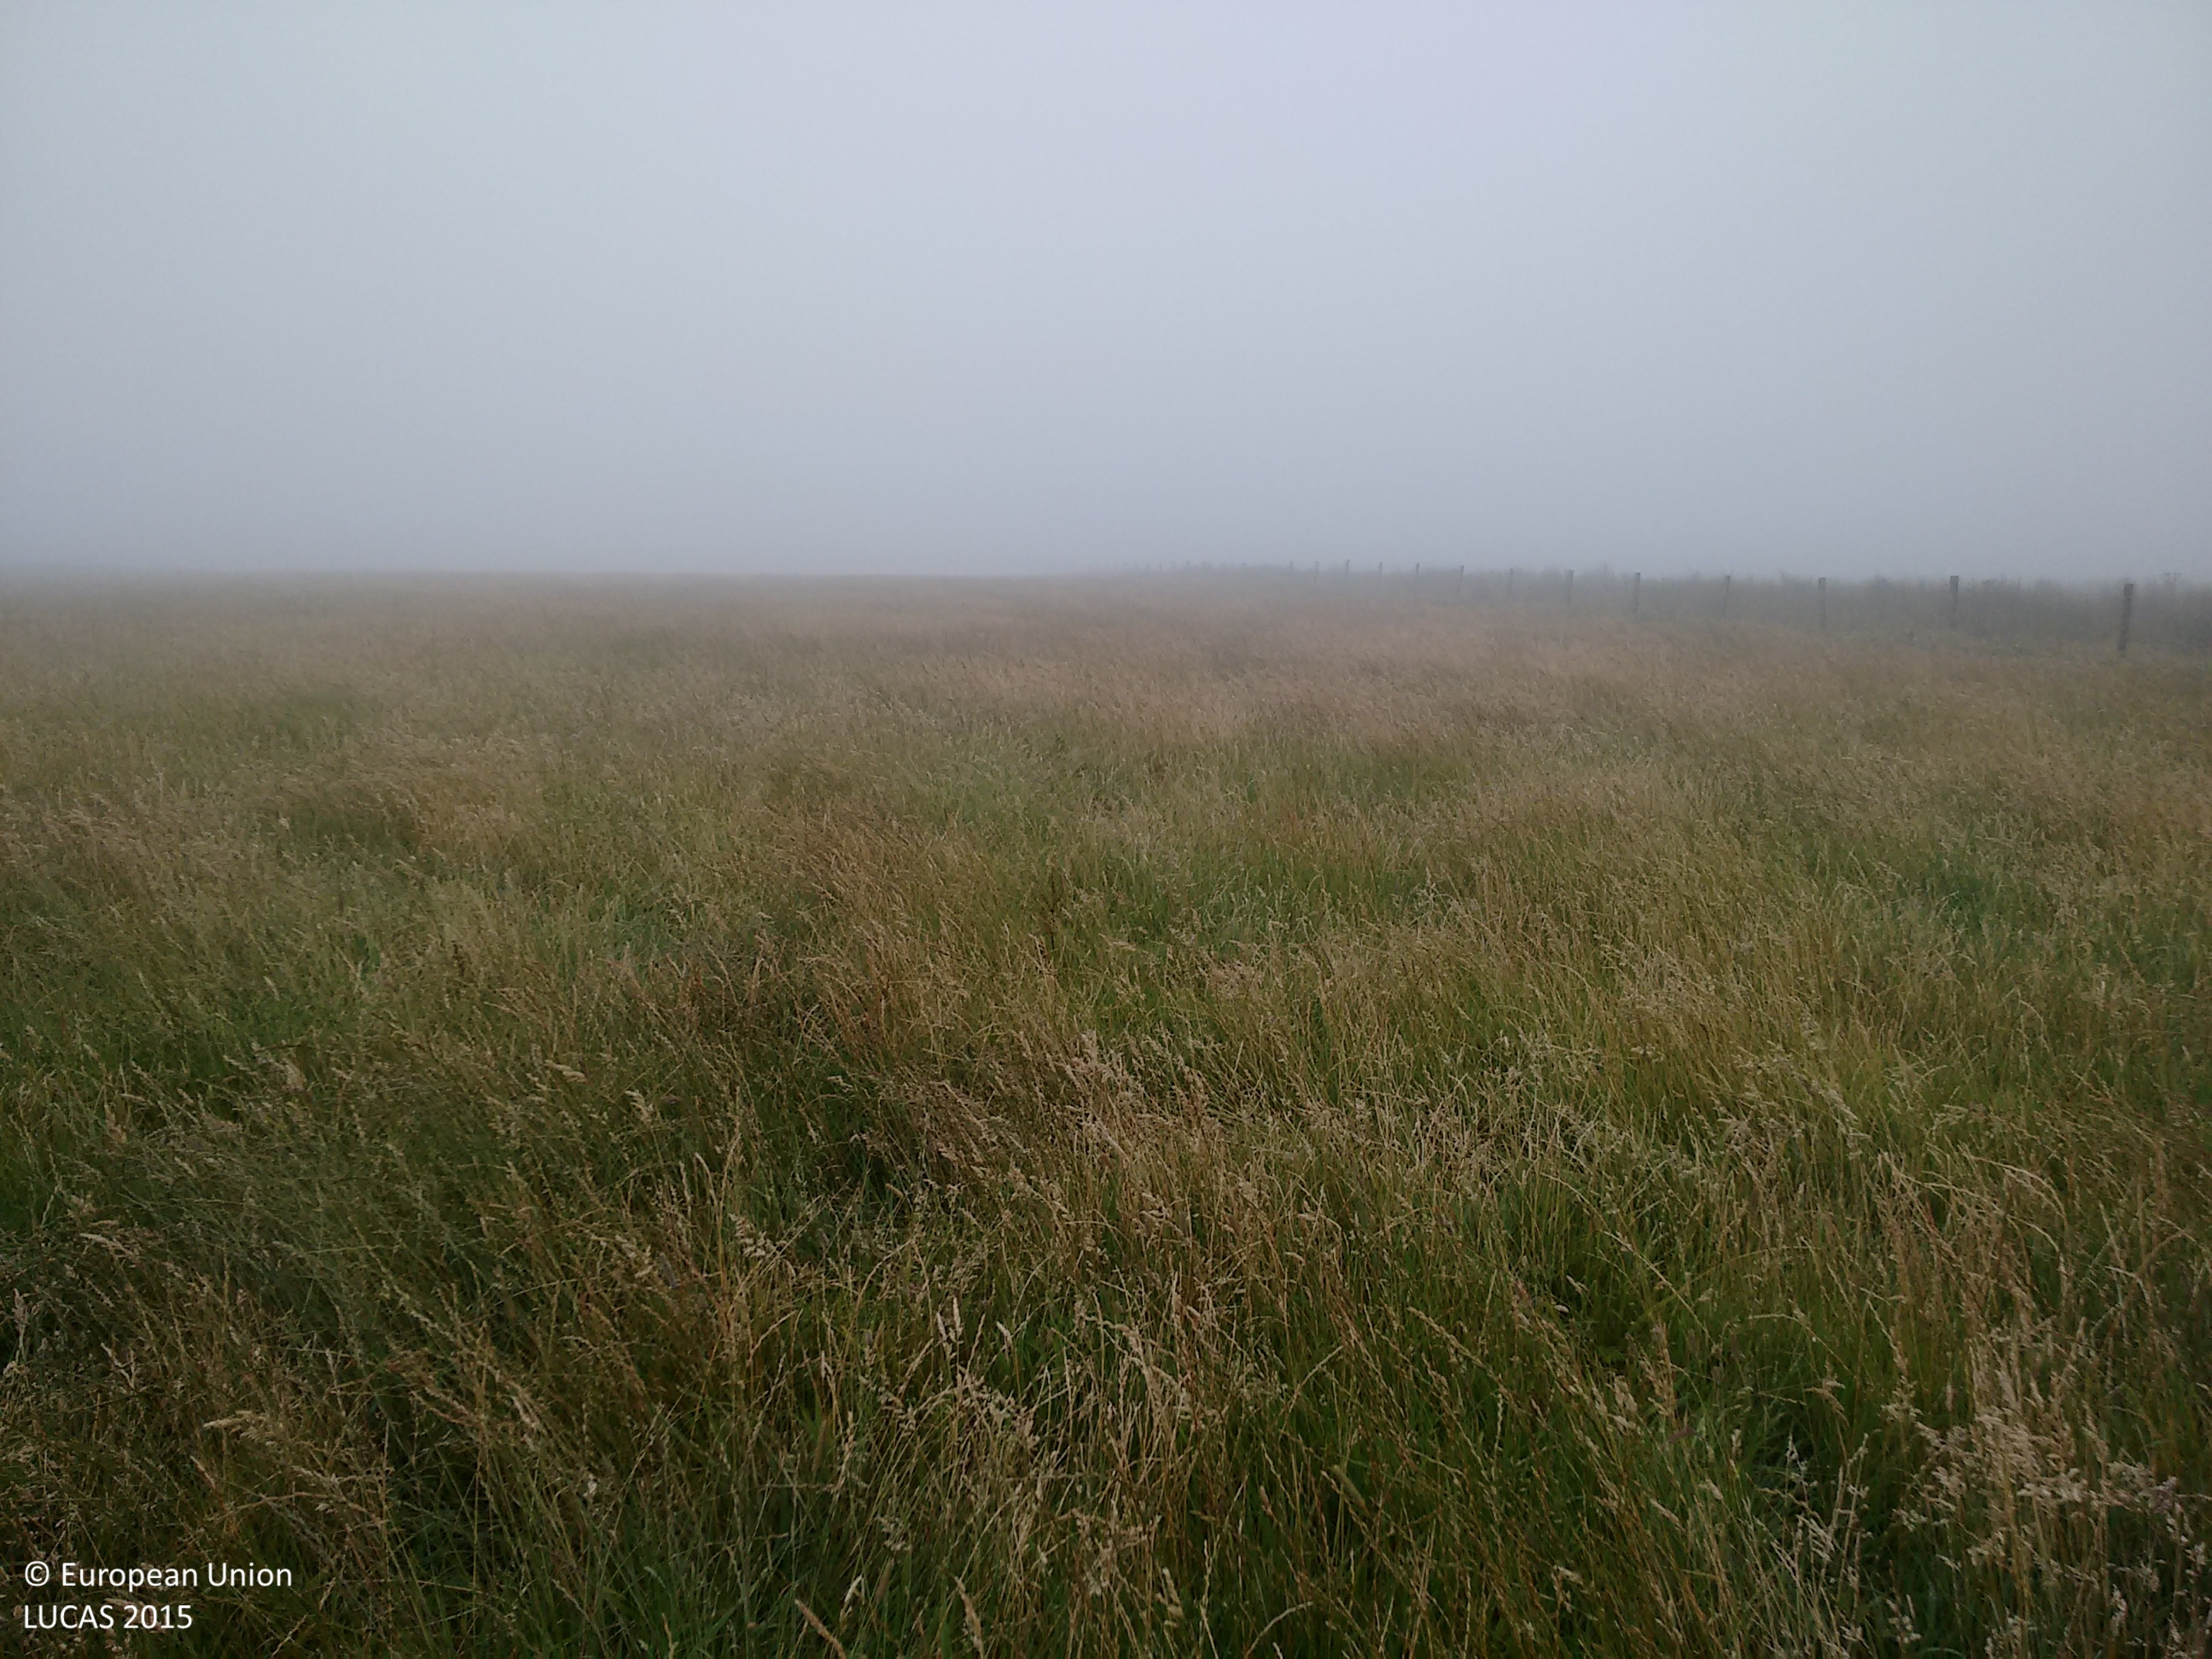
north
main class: Grassland
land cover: Grassland without tree/shrub cover
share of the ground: > 75 %
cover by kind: herbaceous plants 100 %
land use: Agriculture (excluding fallow land and kitchen gardens)
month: August
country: GB
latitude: 51.1467
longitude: -3.7991
